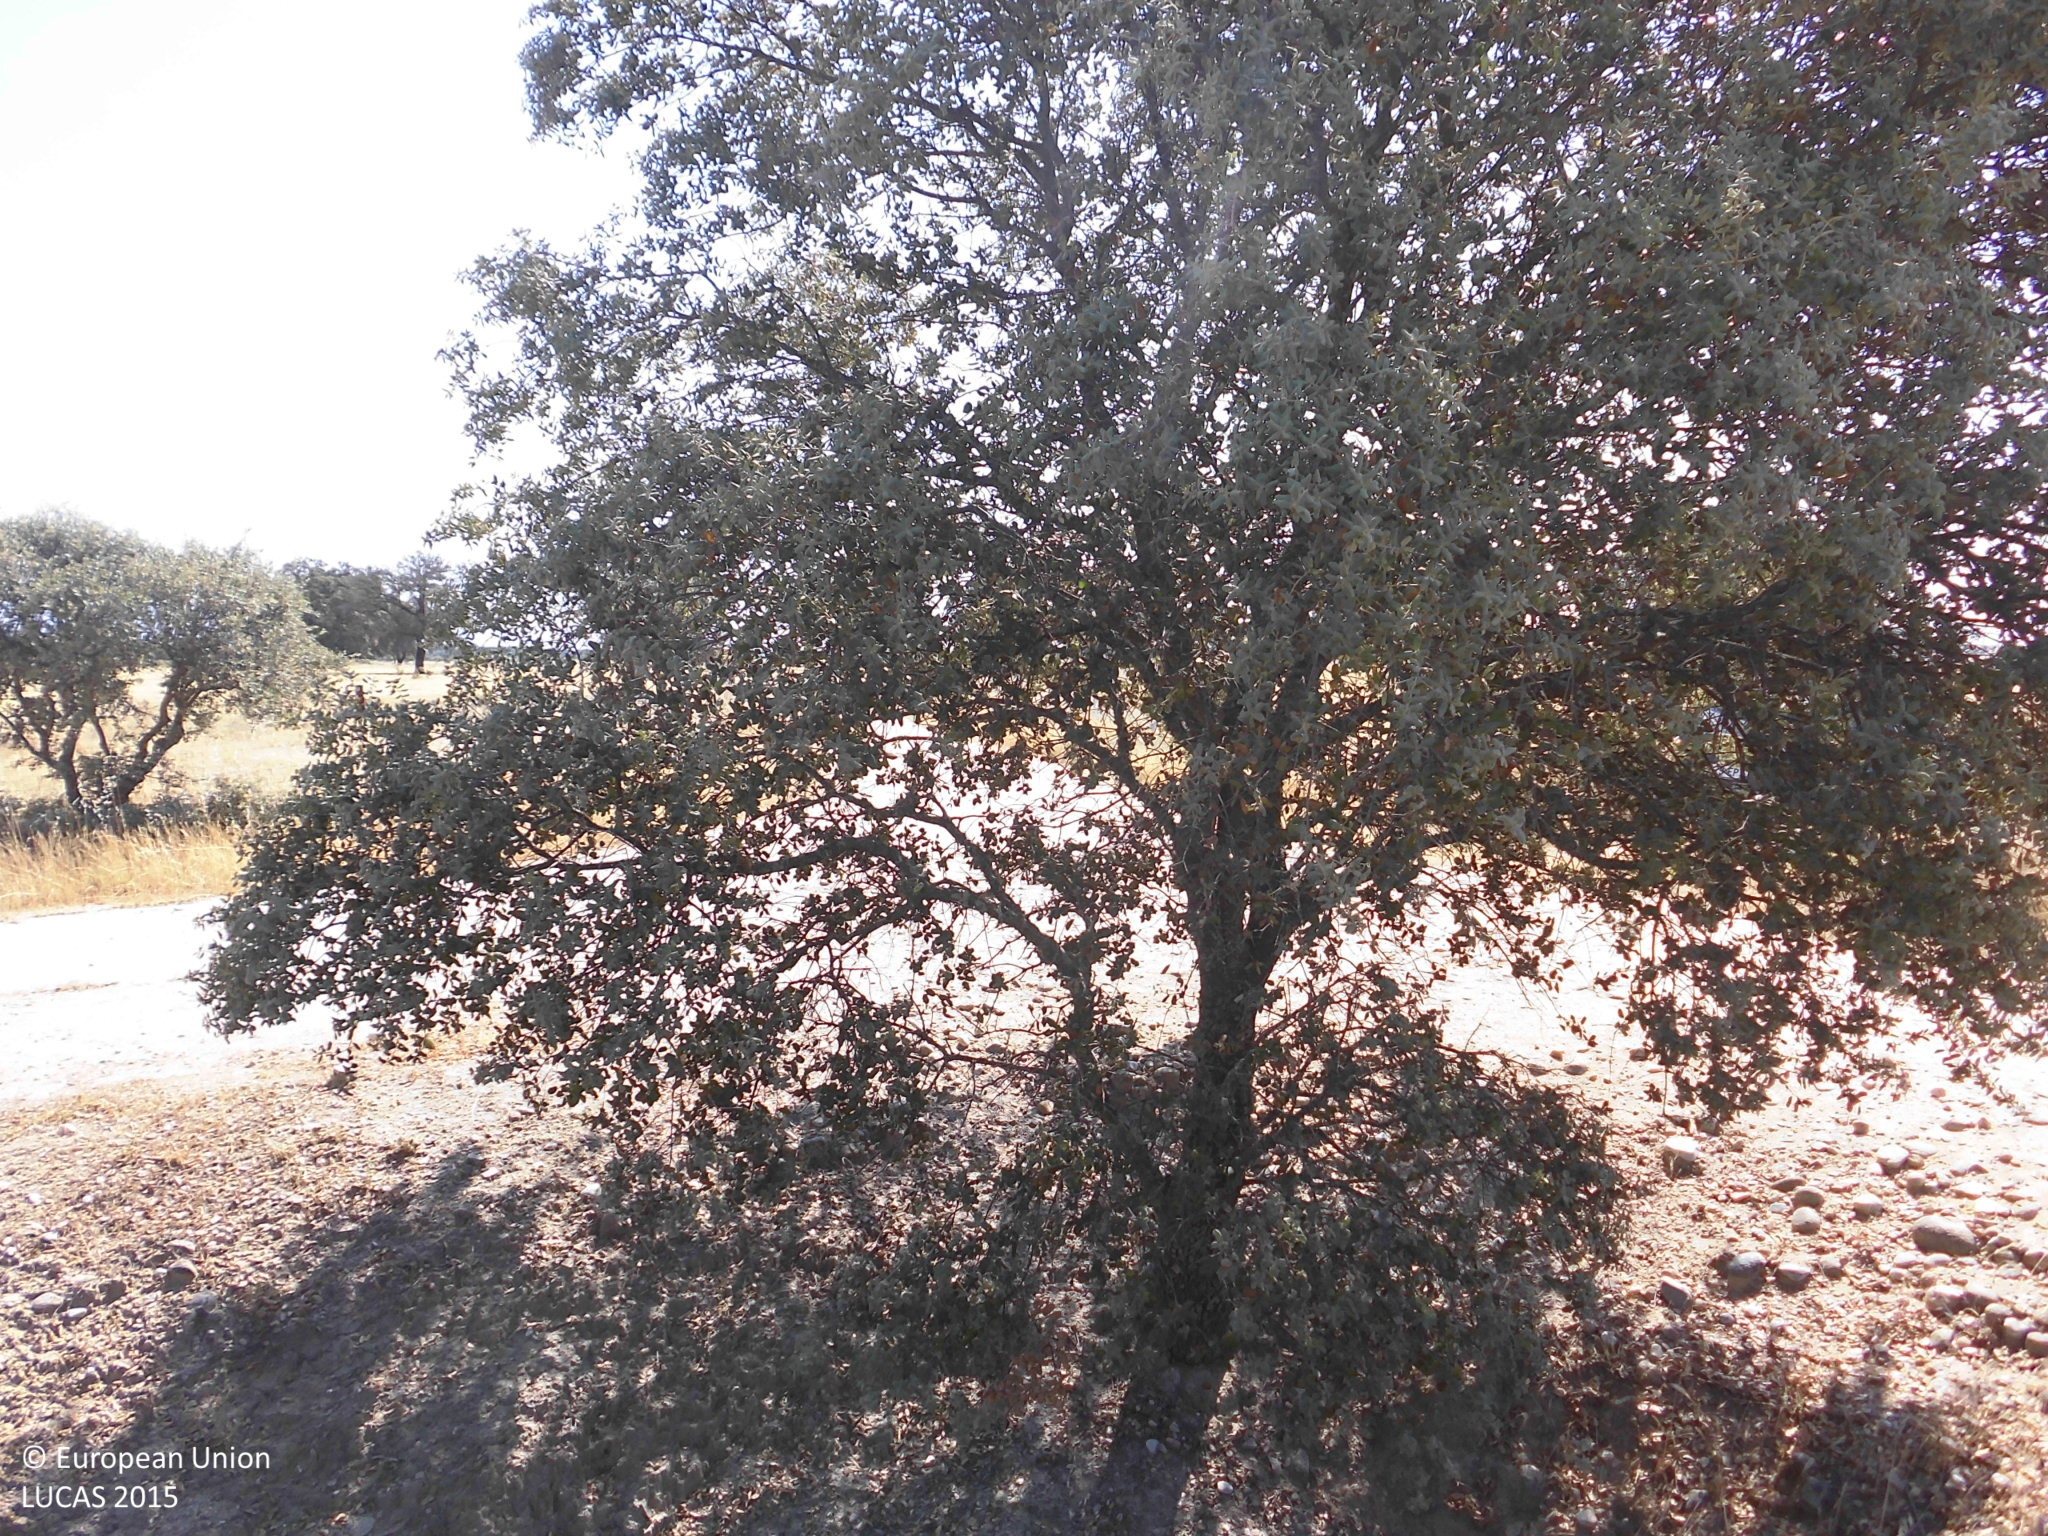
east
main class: Grassland
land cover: Grassland with sparse tree/shrub cover
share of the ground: 25 - 50 %
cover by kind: herbaceous plants 60 %, consolidated bare surface 30 %, broadleaved forest trees 5 %, shrubs 5 %
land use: Abandoned areas
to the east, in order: Grassland with sparse tree/shrub cover; Ditches and canals; Tracks; Grass margins; Fences; Grassland without tree/shrub cover; Fences; Grass margins; Tracks; Grass margins
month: June
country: ES
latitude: 40.0249
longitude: -5.4681
